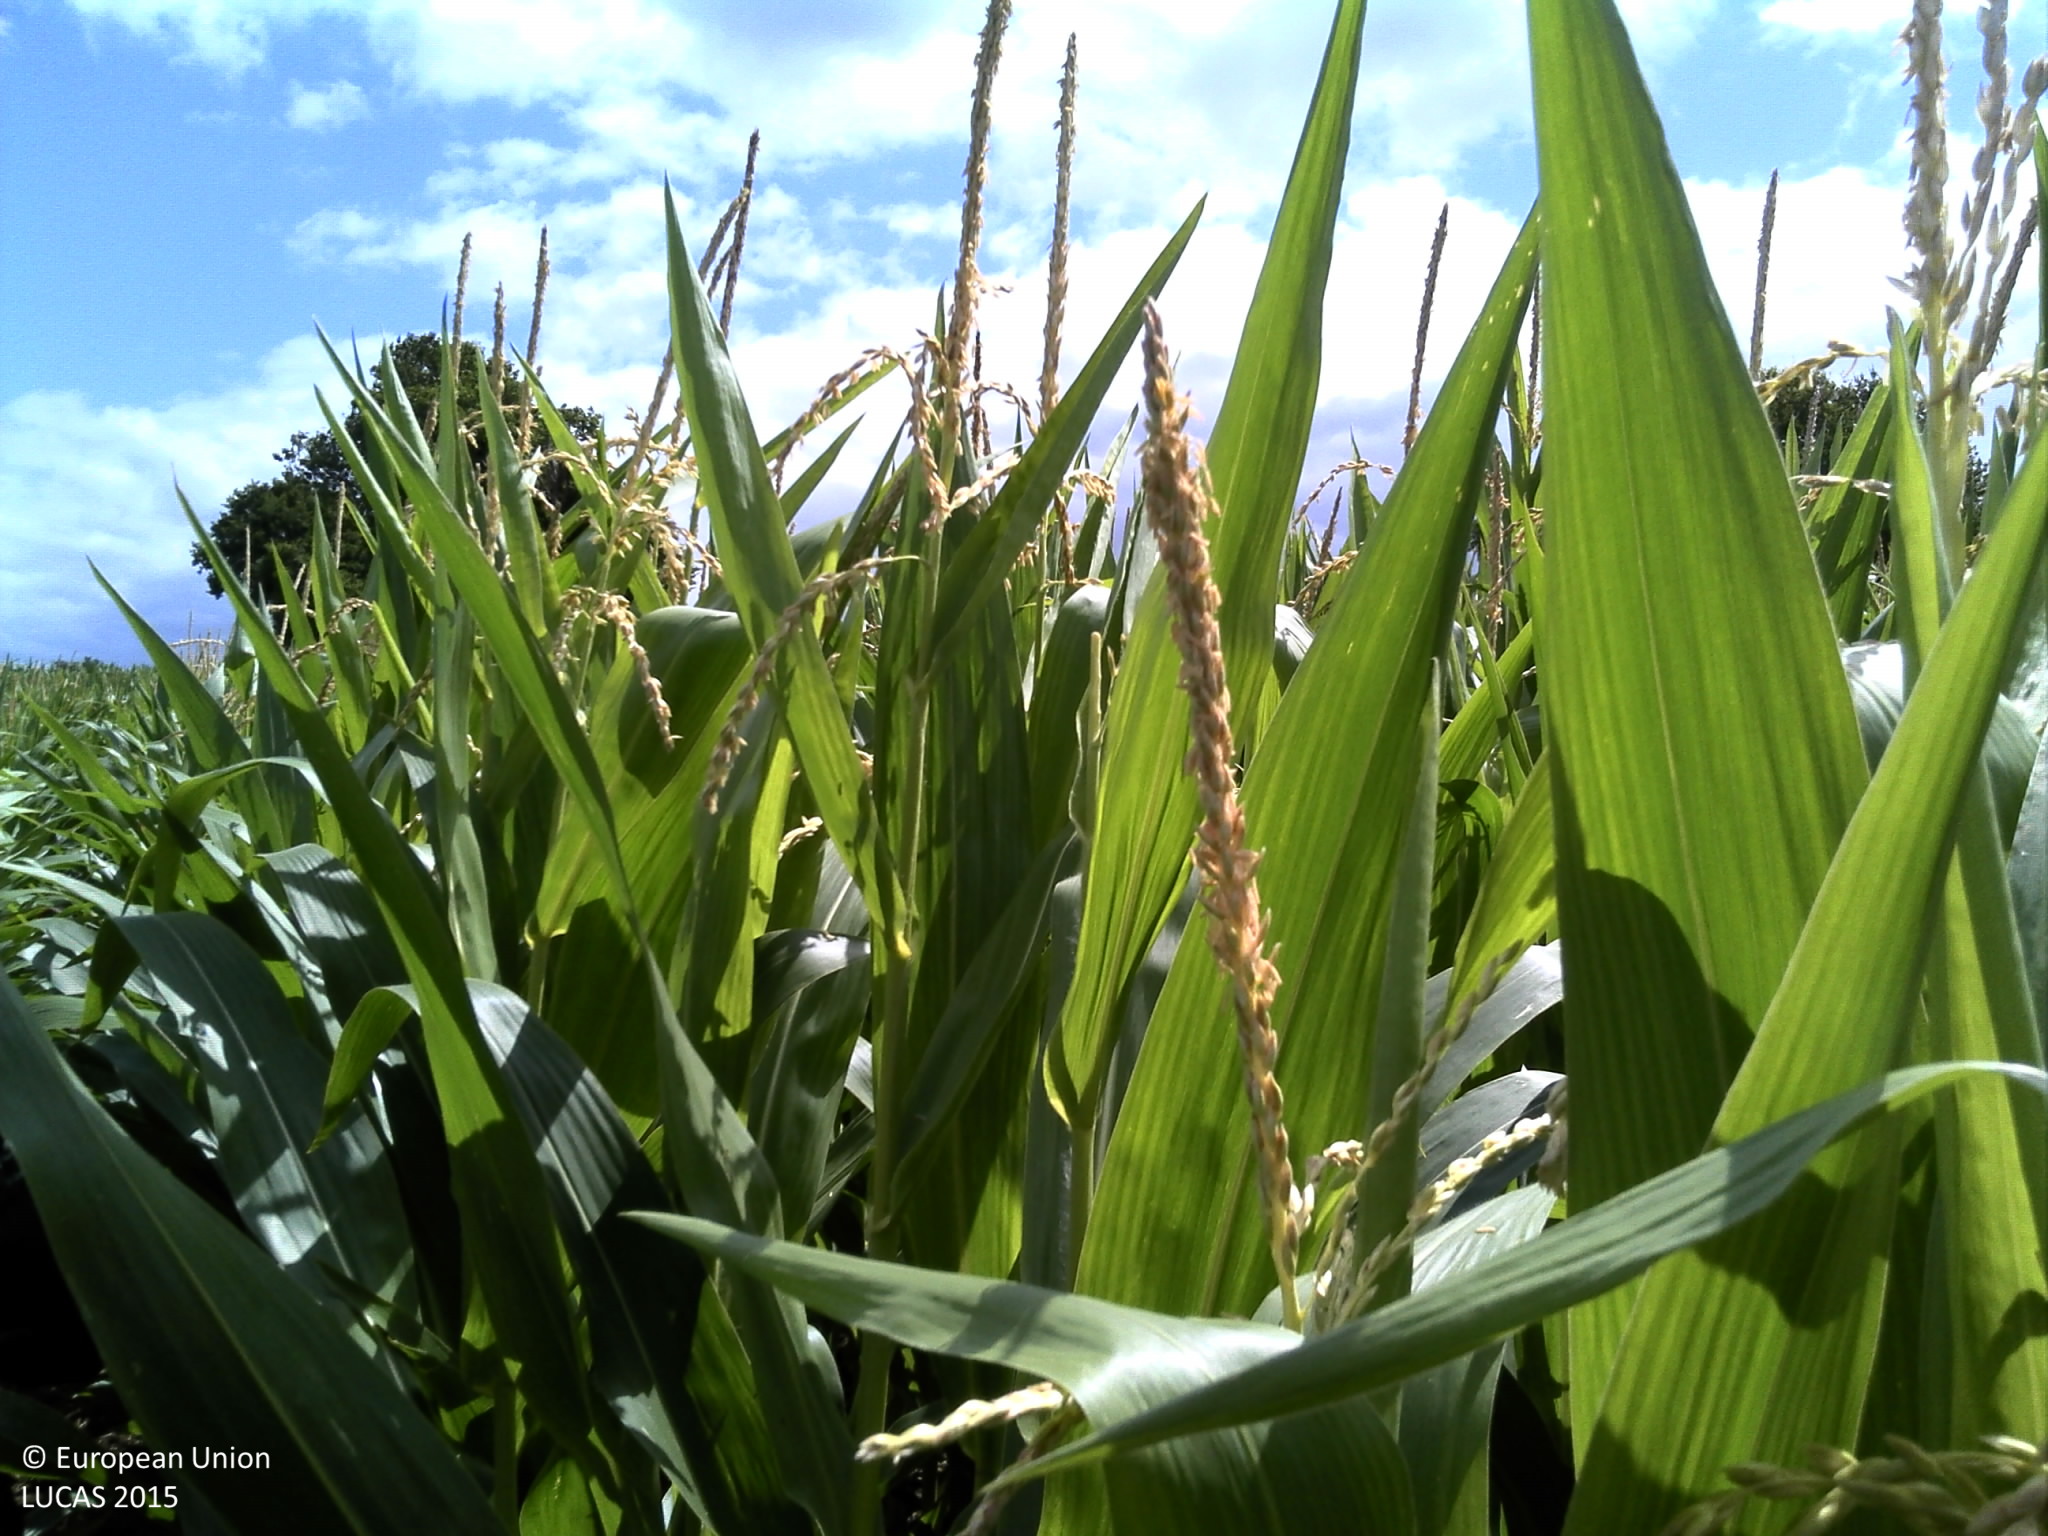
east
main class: Cropland
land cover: Maize
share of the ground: > 75 %
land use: Agriculture (excluding fallow land and kitchen gardens)
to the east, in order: Maize; Managed hedges; Maize
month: July
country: FR
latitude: 48.2927
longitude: -3.7092
